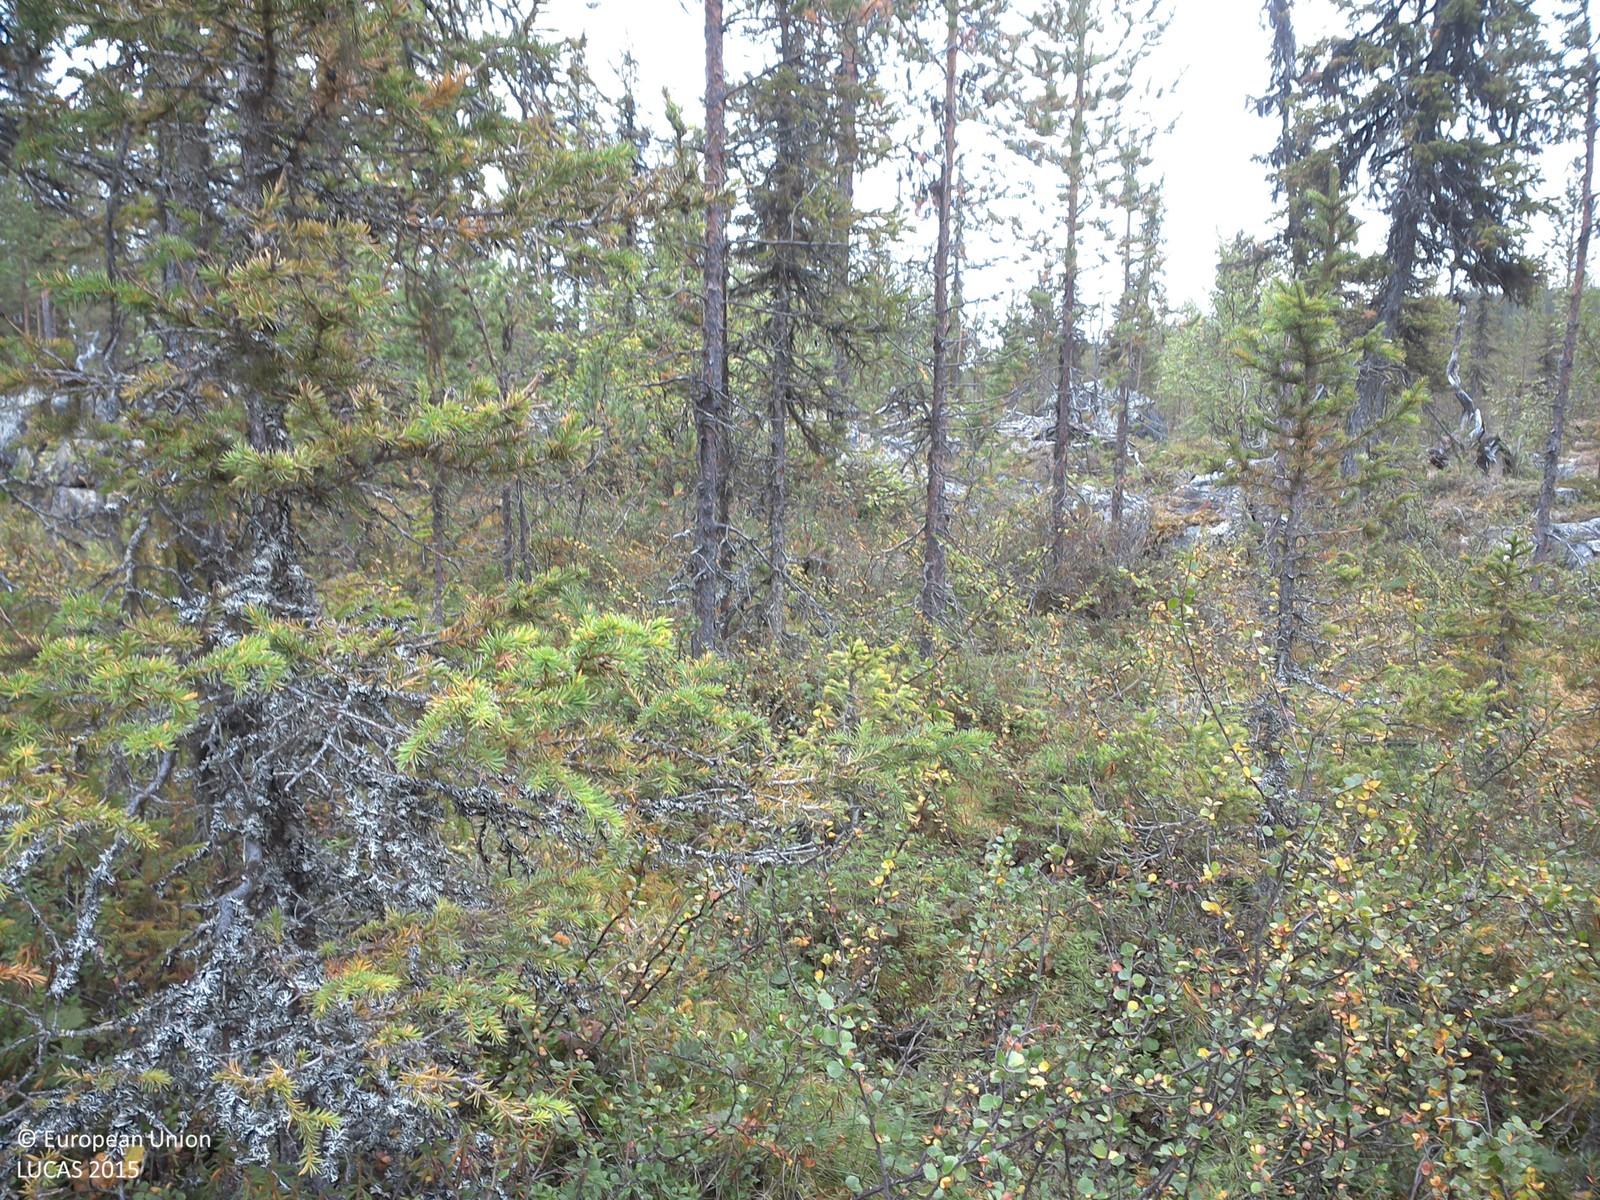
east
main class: Woodland
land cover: Spruce dominated coniferous woodland
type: boreal forest
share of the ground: 10 - 25 %
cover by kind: shrubs 60 %, coniferous forest trees 20 %, lichens and mosses 20 %
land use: Forestry
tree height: > 5 m
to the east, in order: Spruce dominated coniferous woodland; Pine dominated mixed woodland; Pine dominated coniferous woodland; Inland marshes; Pine dominated coniferous woodland; Inland marshes; Pine dominated coniferous woodland
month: August
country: SE
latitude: 67.8295
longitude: 21.4618
